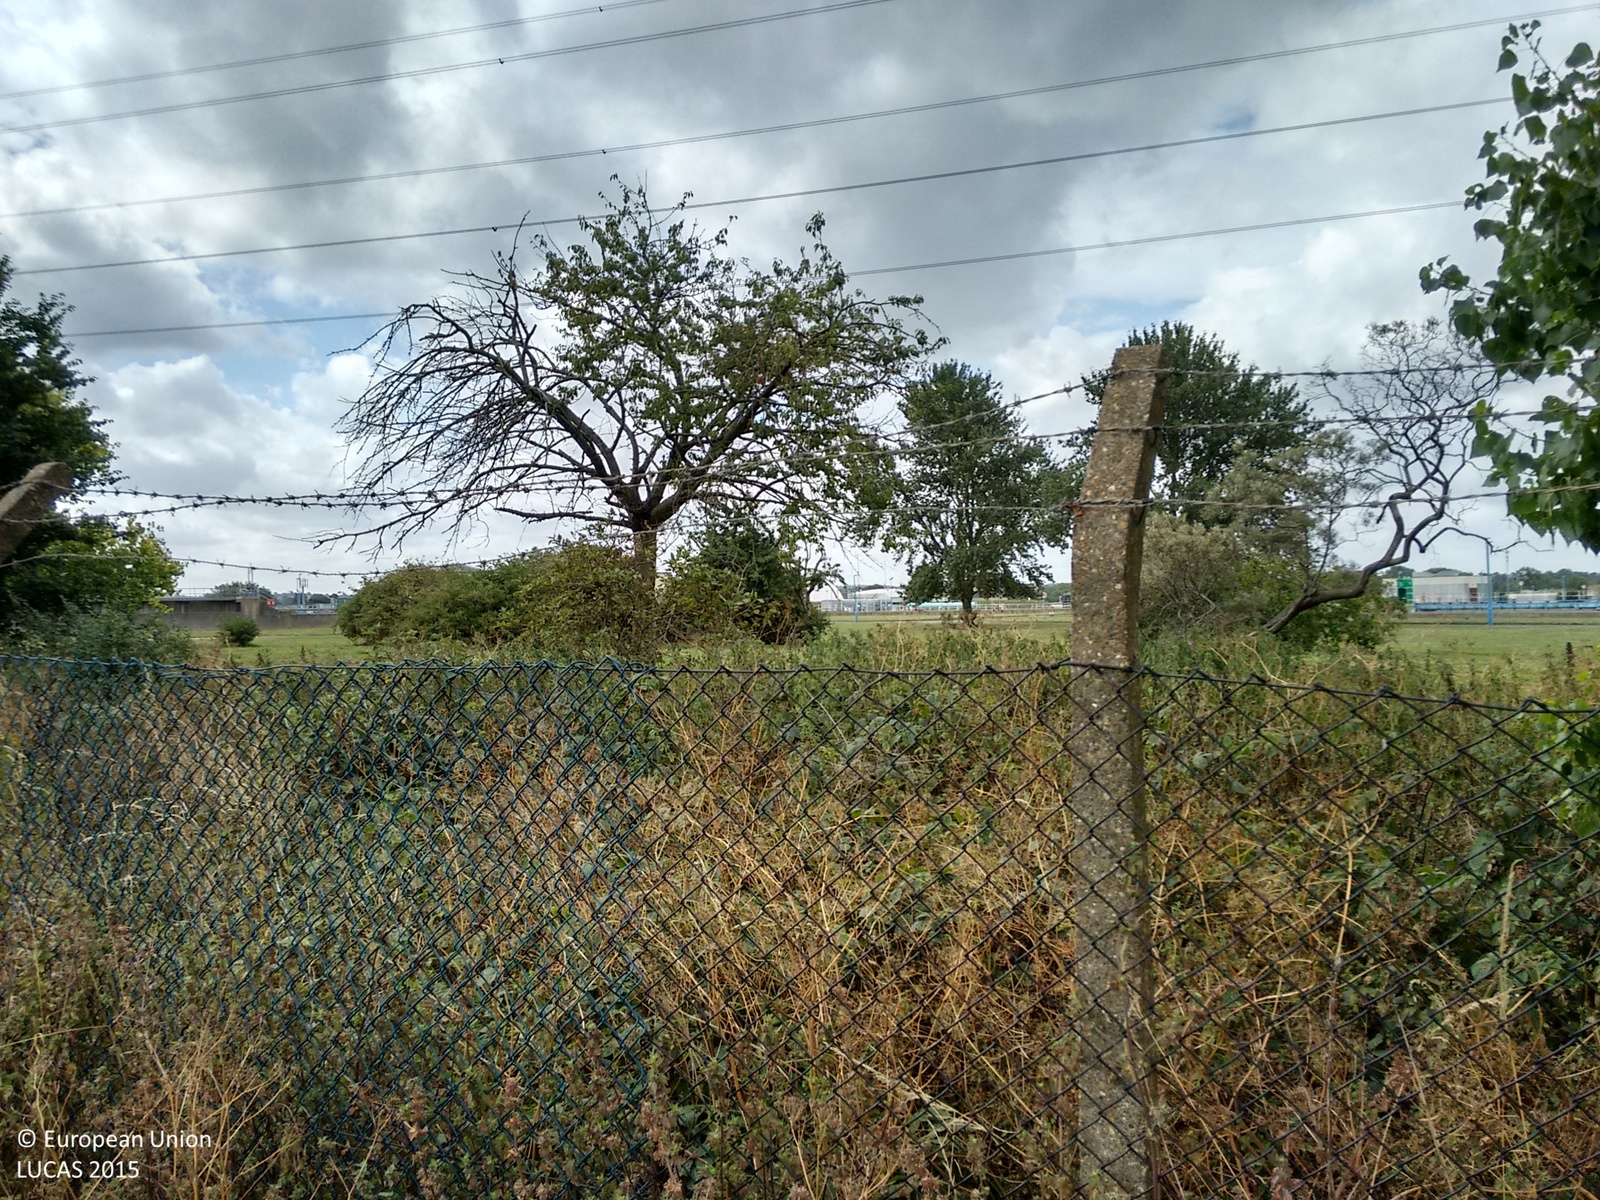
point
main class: Grassland
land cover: Grassland with sparse tree/shrub cover
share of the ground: > 75 %
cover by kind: herbaceous plants 95 %, broadleaved forest trees 5 %
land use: Waste treatment
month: August
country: GB
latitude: 51.3808
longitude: -0.1350
